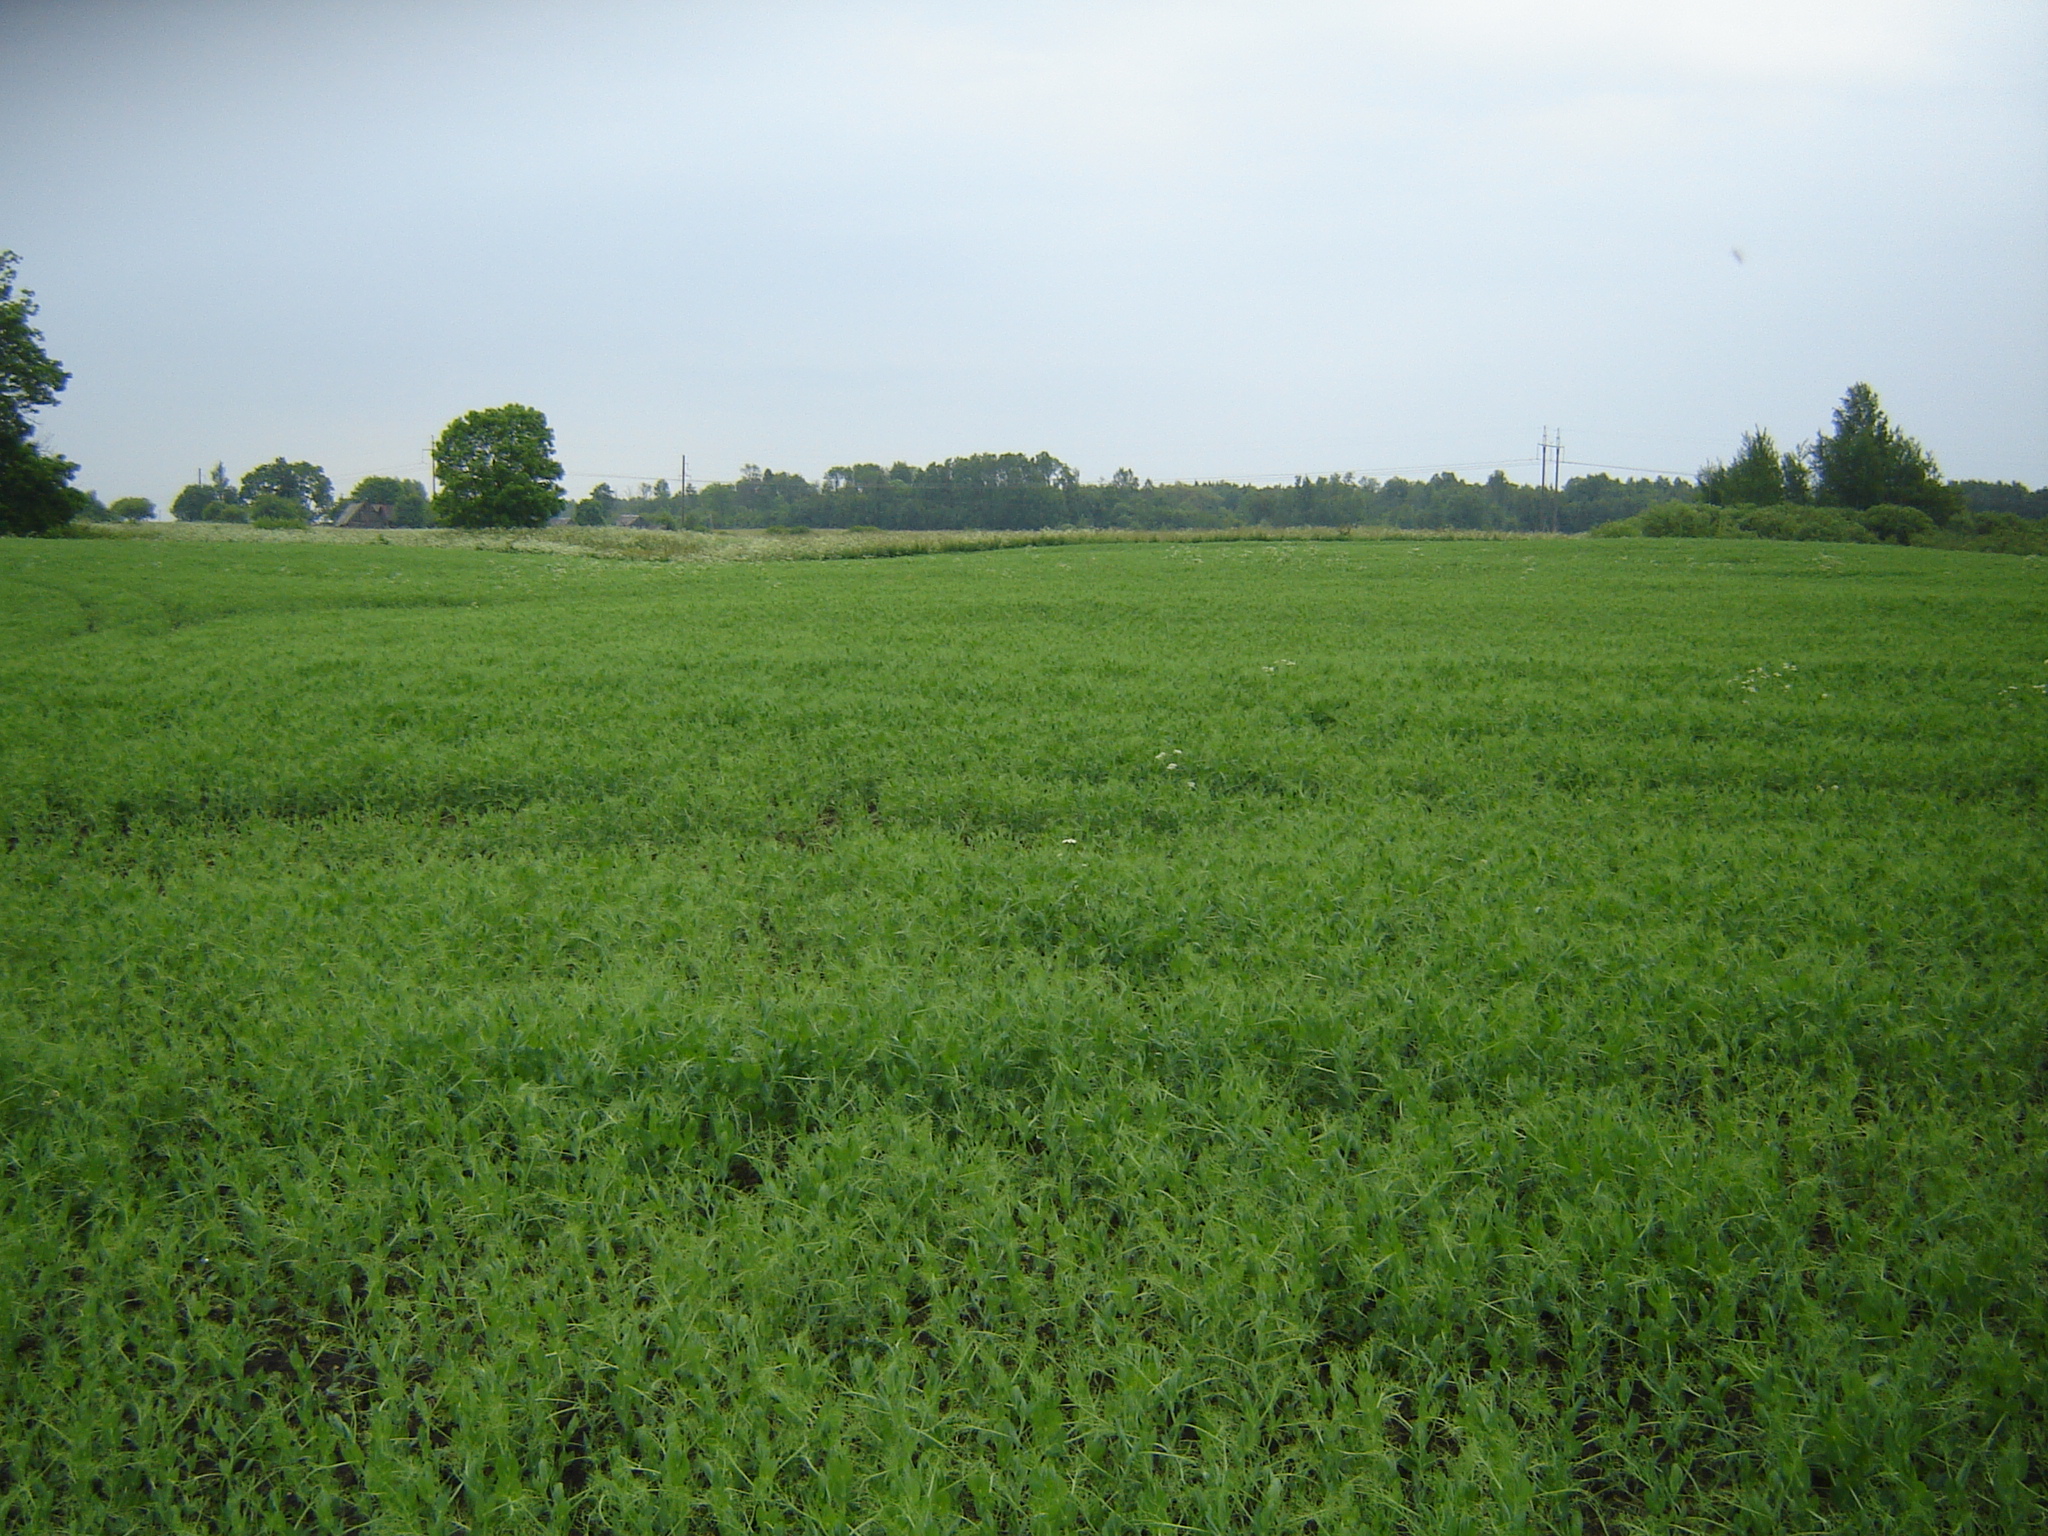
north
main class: Cropland
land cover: Dry pulses
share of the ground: > 75 %
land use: Agriculture (excluding fallow land and kitchen gardens)
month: June
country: LT
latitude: 55.5606
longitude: 25.2596
